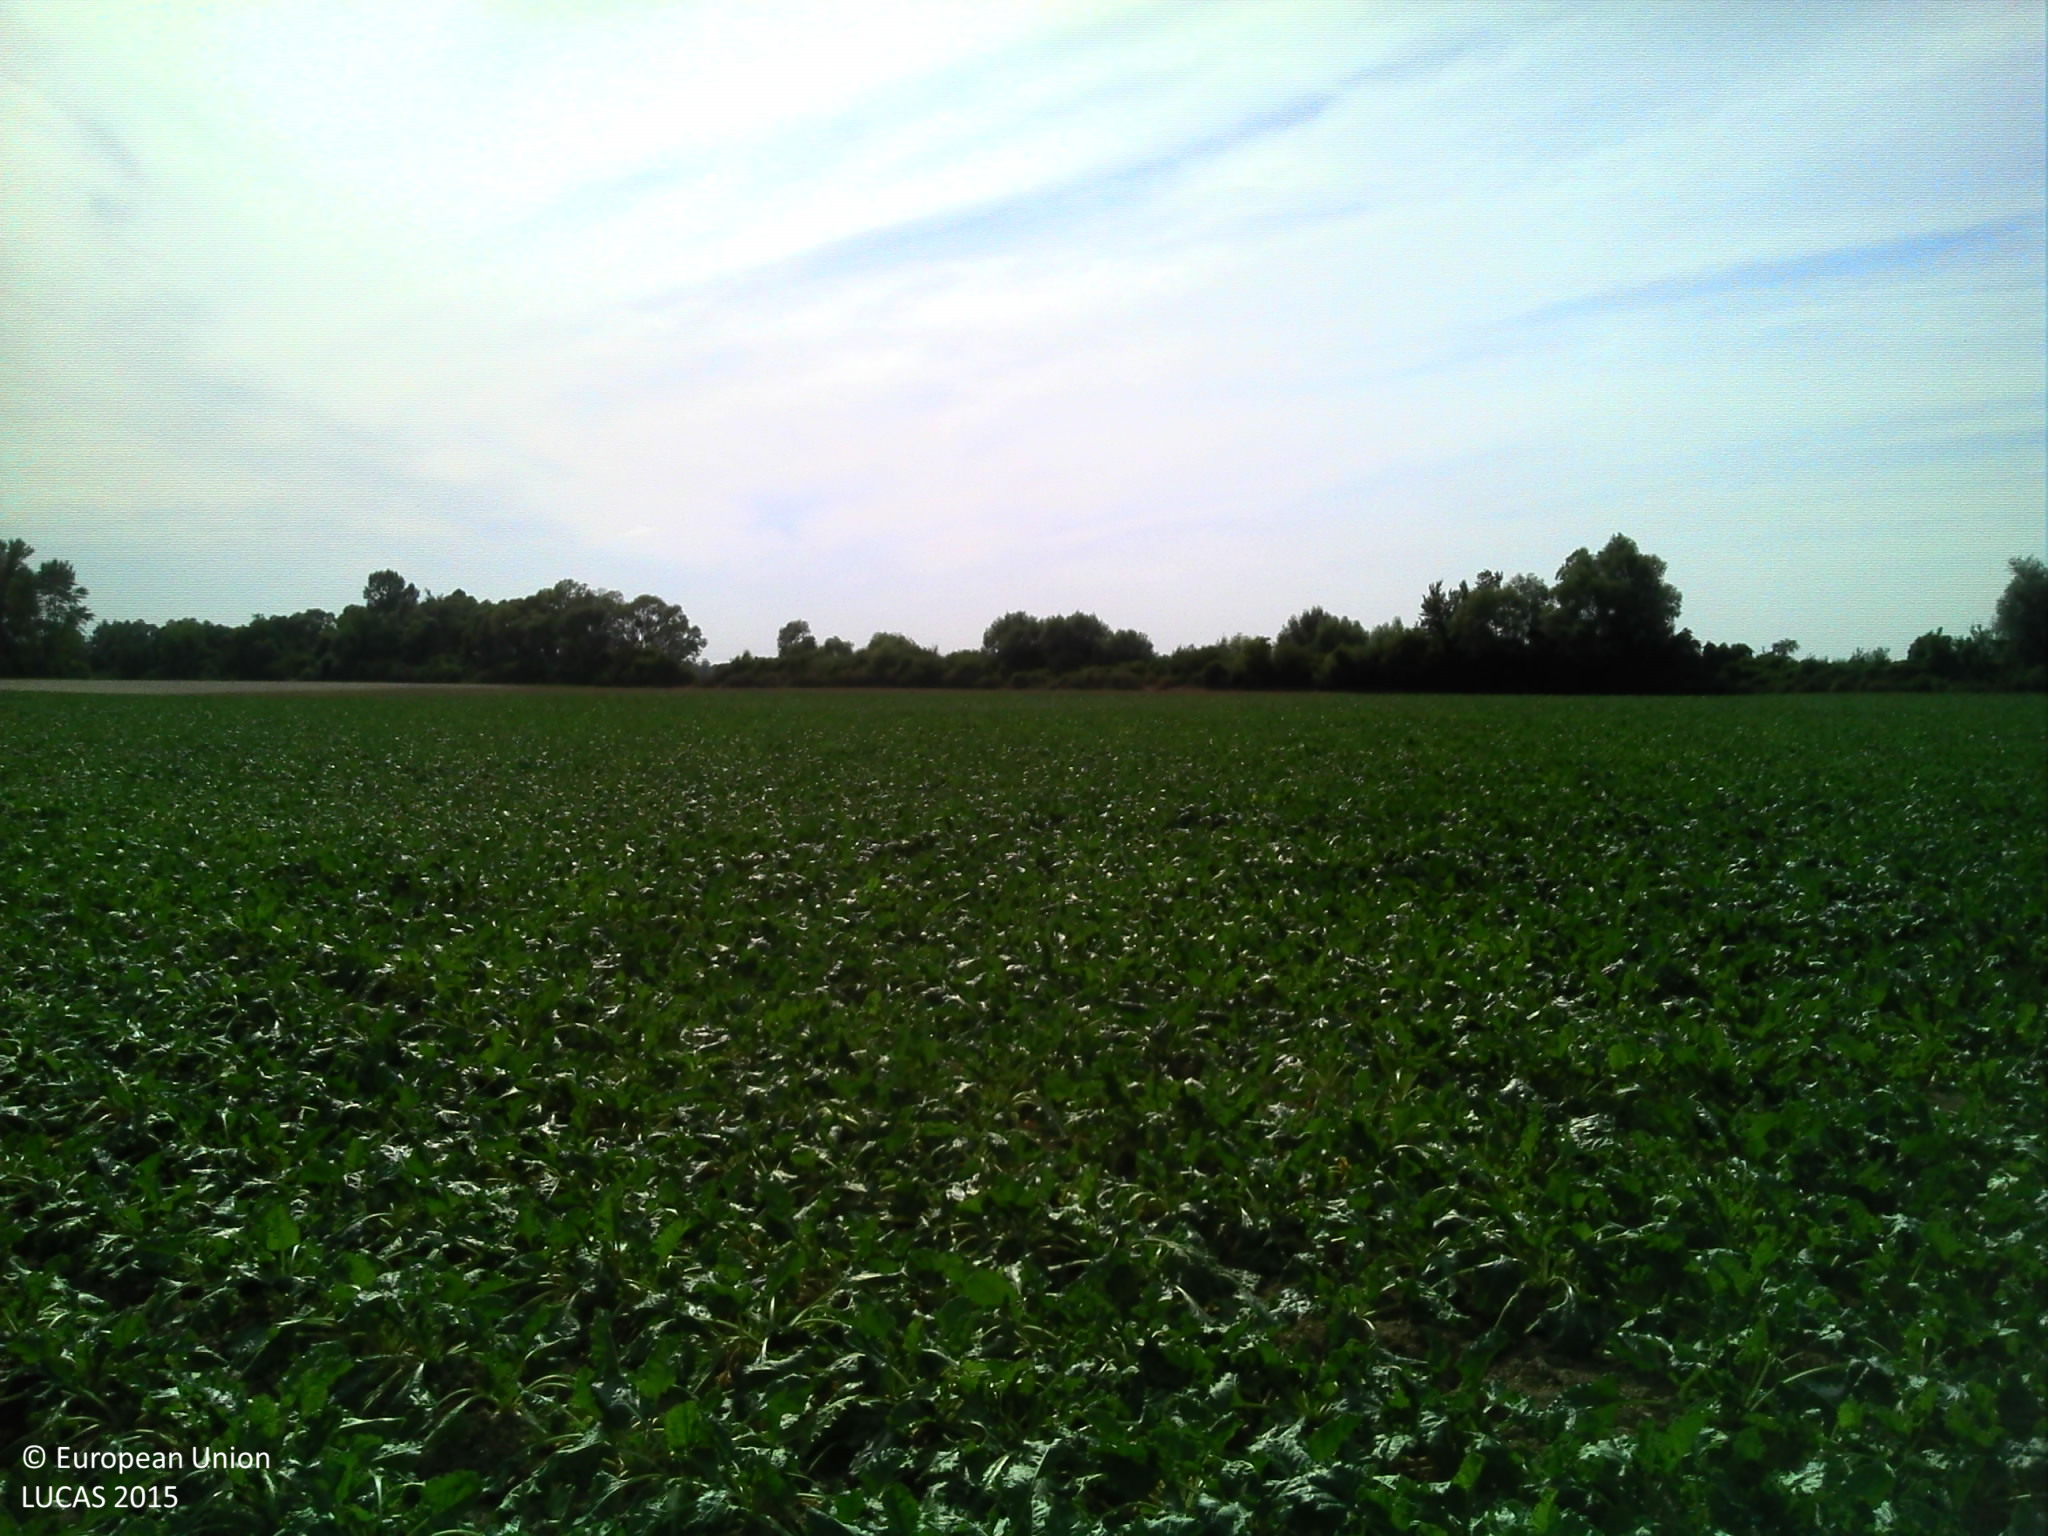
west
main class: Cropland
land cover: Sugar beet
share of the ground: > 75 %
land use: Agriculture (excluding fallow land and kitchen gardens)
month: July
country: FR
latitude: 48.5724
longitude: 3.8013
